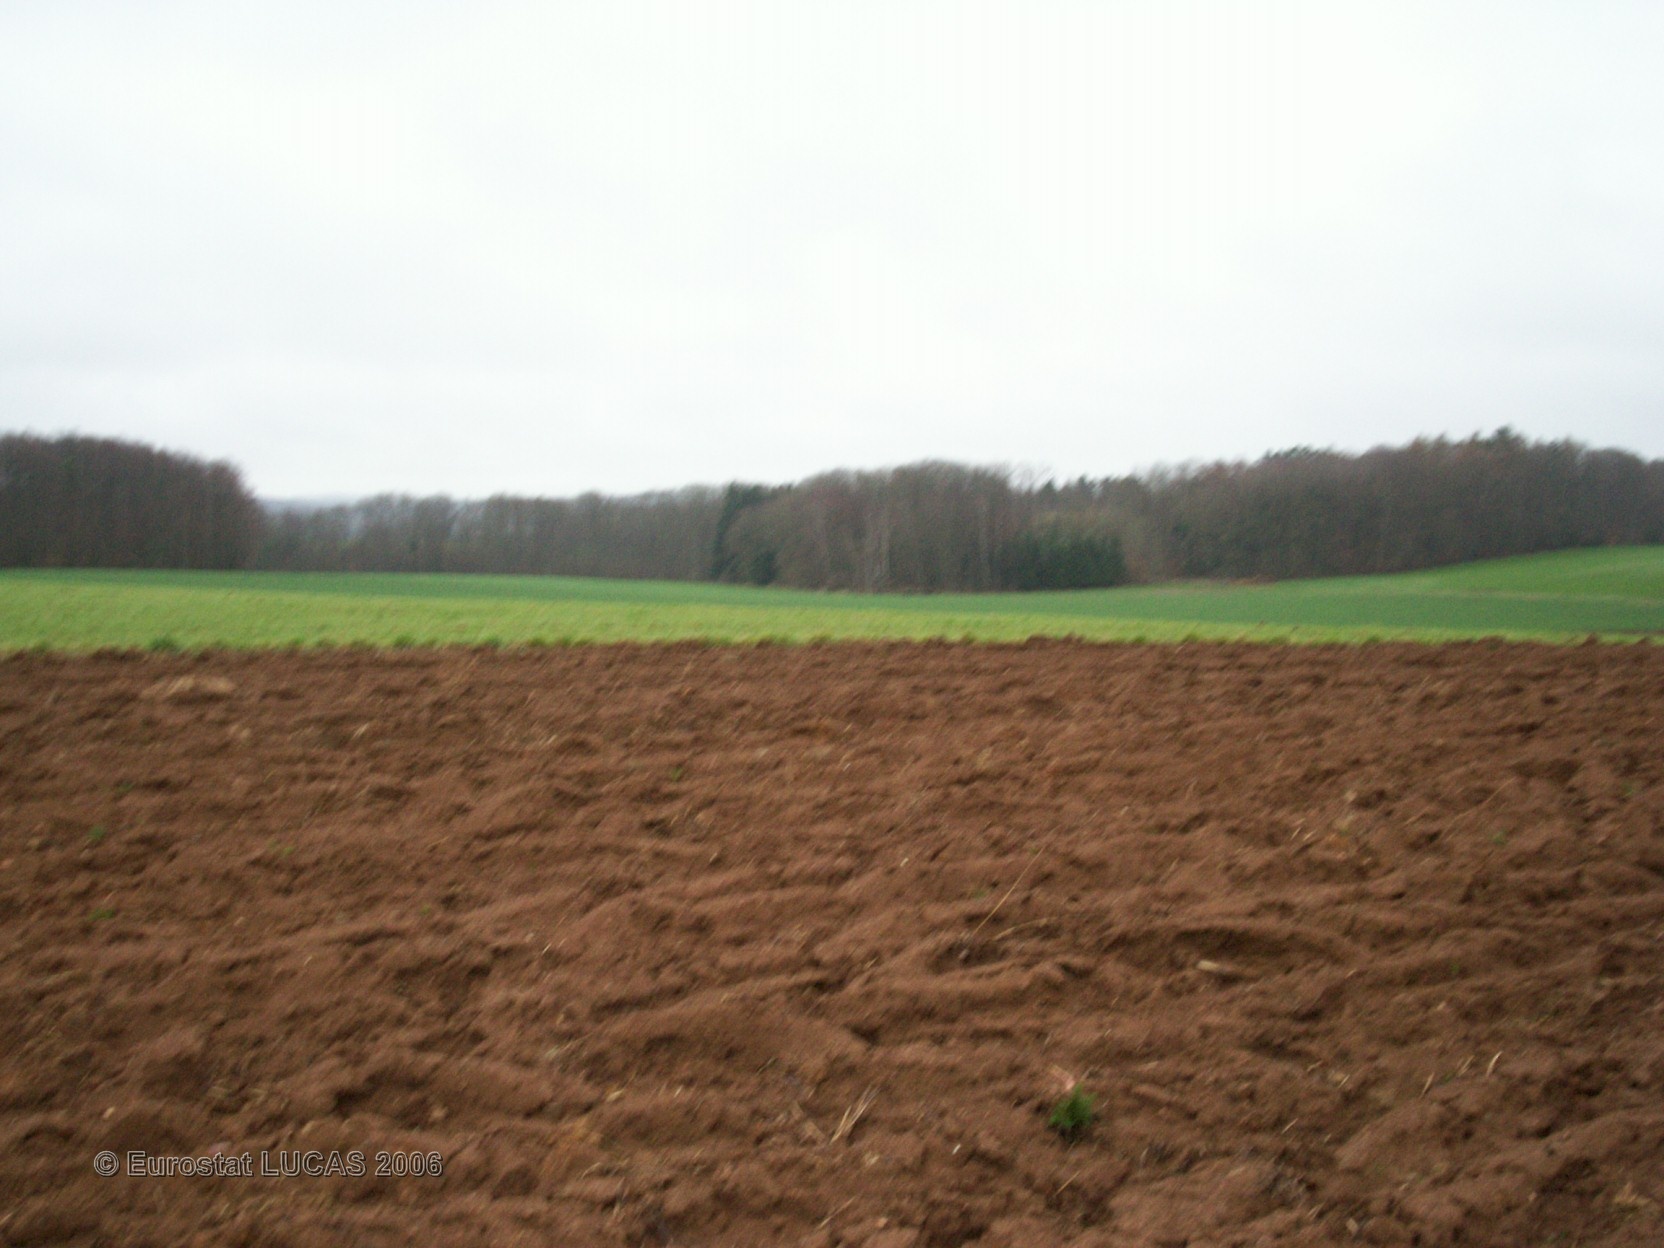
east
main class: Cropland
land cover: Maize
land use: Agriculture (excluding fallow land and kitchen gardens)
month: May
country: FR
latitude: 48.5902
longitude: 6.7602
